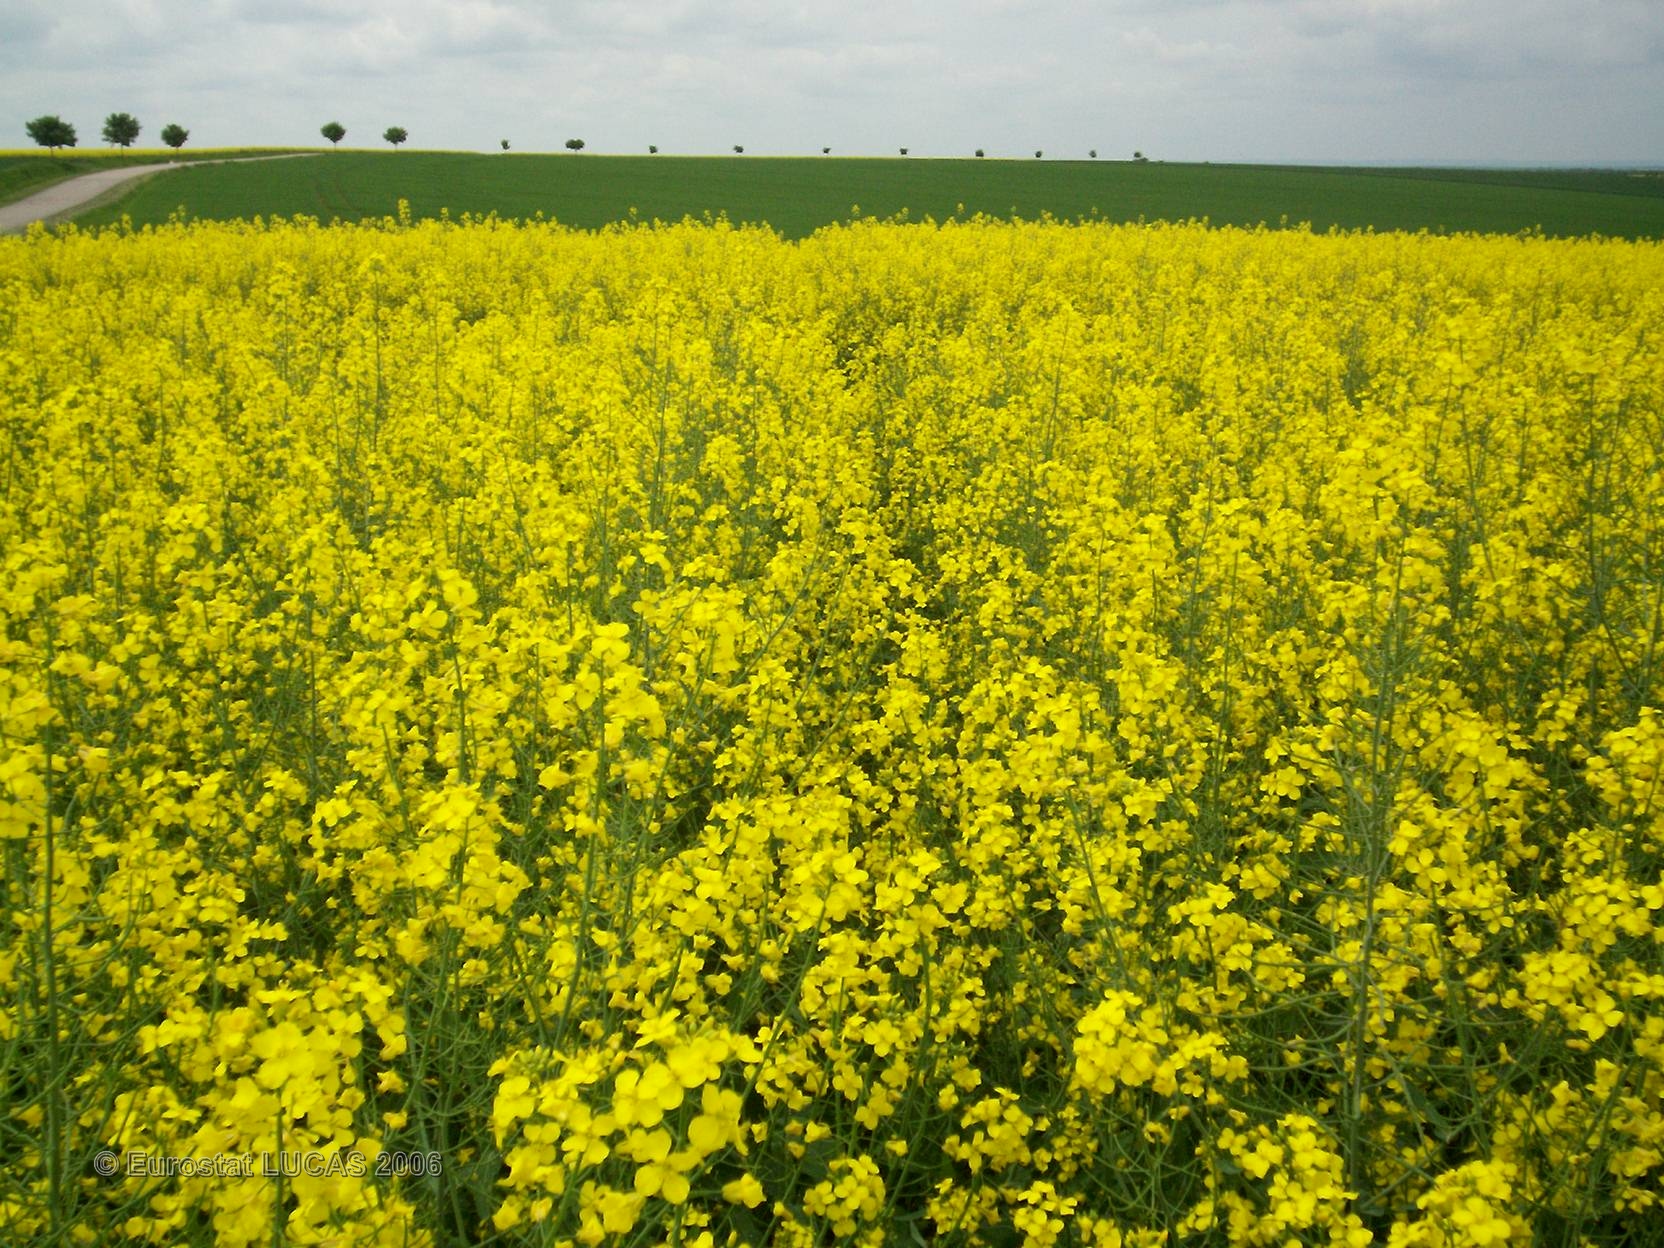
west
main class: Cropland
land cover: Rape and turnip rape
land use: Agriculture (excluding fallow land and kitchen gardens)
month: May
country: FR
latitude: 49.1212
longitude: 5.9299
